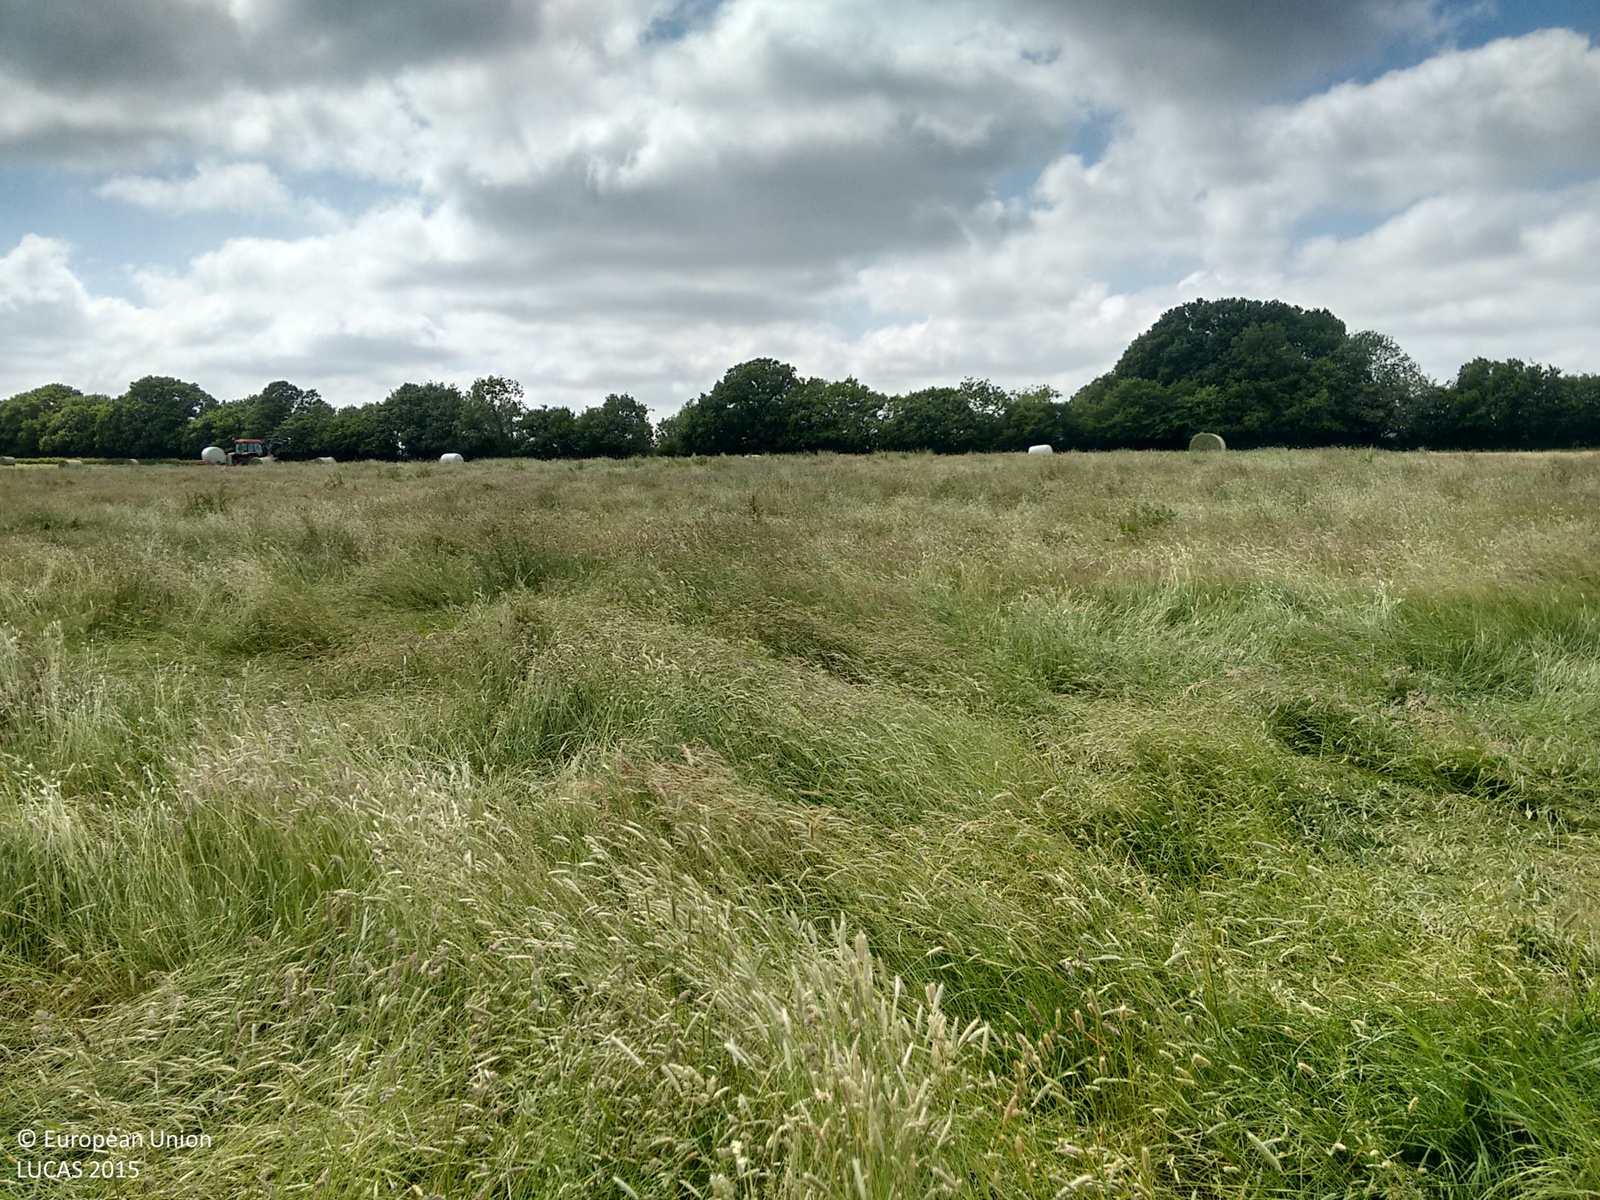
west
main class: Grassland
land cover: Grassland without tree/shrub cover
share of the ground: > 75 %
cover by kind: herbaceous plants 100 %
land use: Agriculture (excluding fallow land and kitchen gardens)
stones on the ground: < 10 %
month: June
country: GB
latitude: 51.1335
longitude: 0.5838
